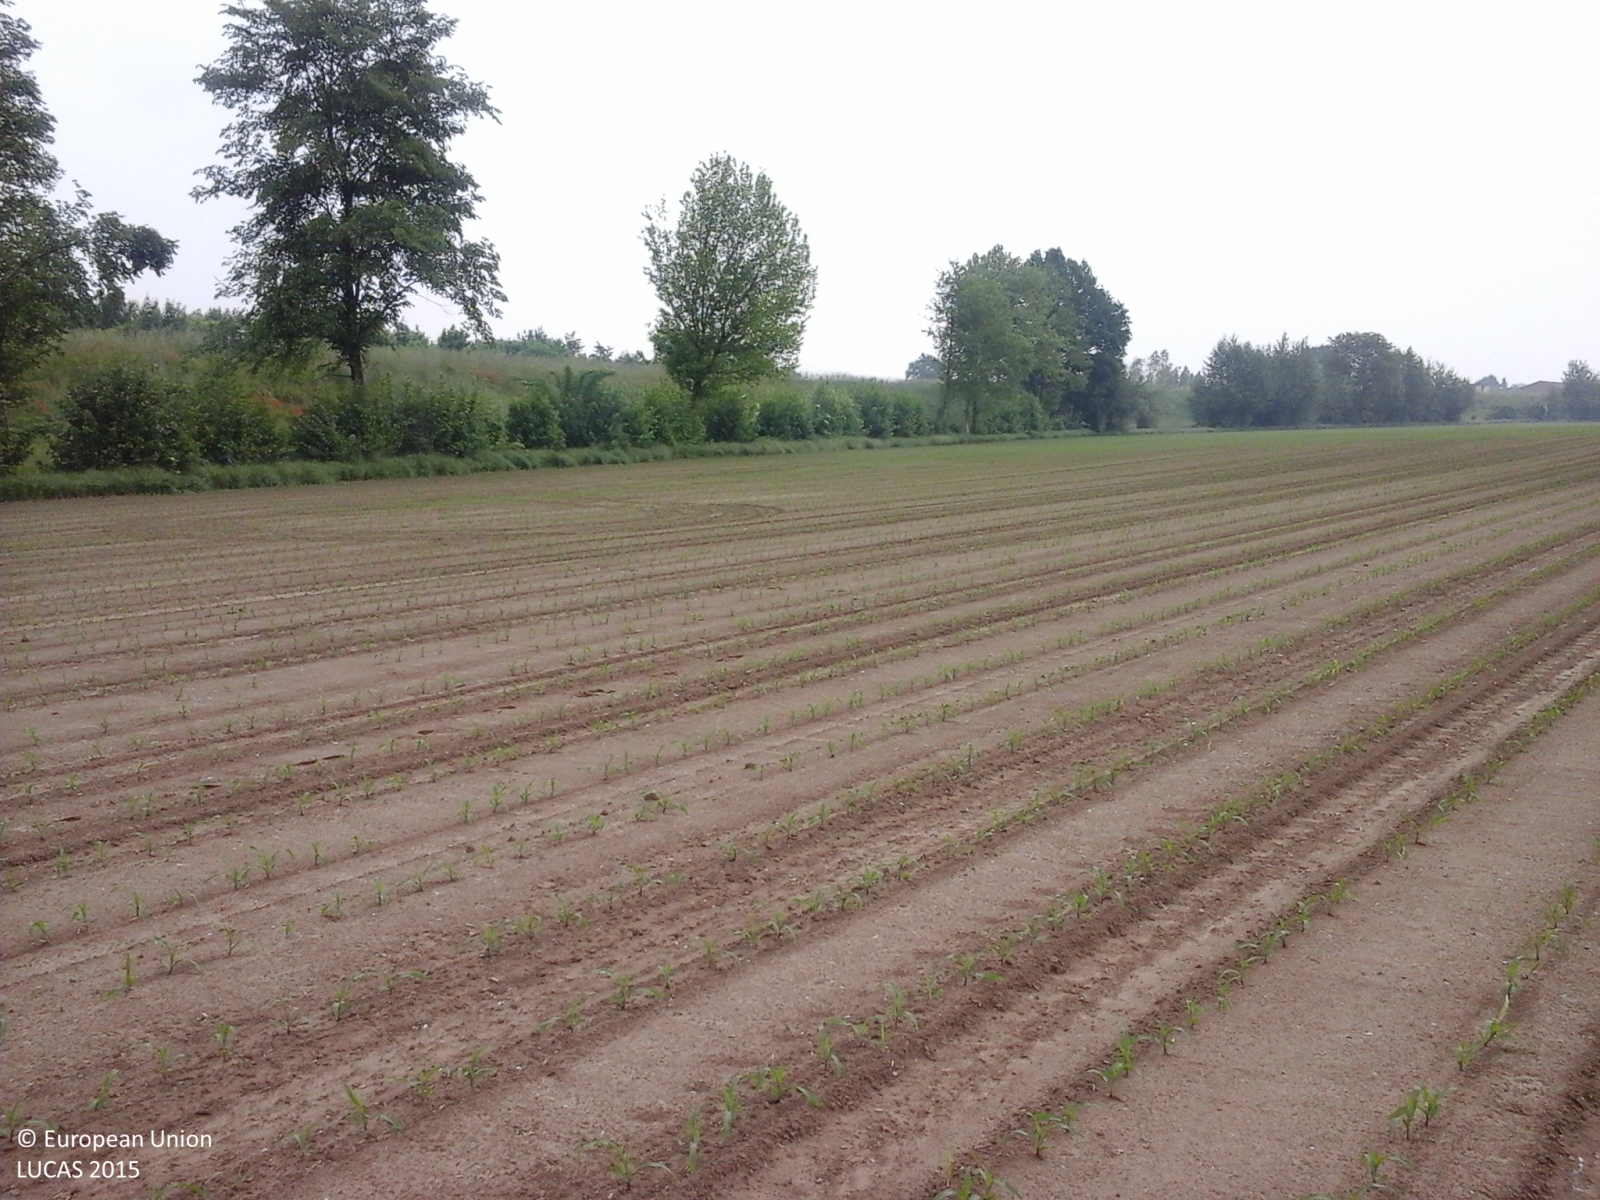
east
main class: Cropland
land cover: Maize
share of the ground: < 10 %
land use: Agriculture (excluding fallow land and kitchen gardens)
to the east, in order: Maize; Abandoned hedges; Ditches and canals; Grassland without tree/shrub cover; Paved roads, cycling and walking lanes; Grassland without tree/shrub cover
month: May
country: IT
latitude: 45.0717
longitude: 10.1648
